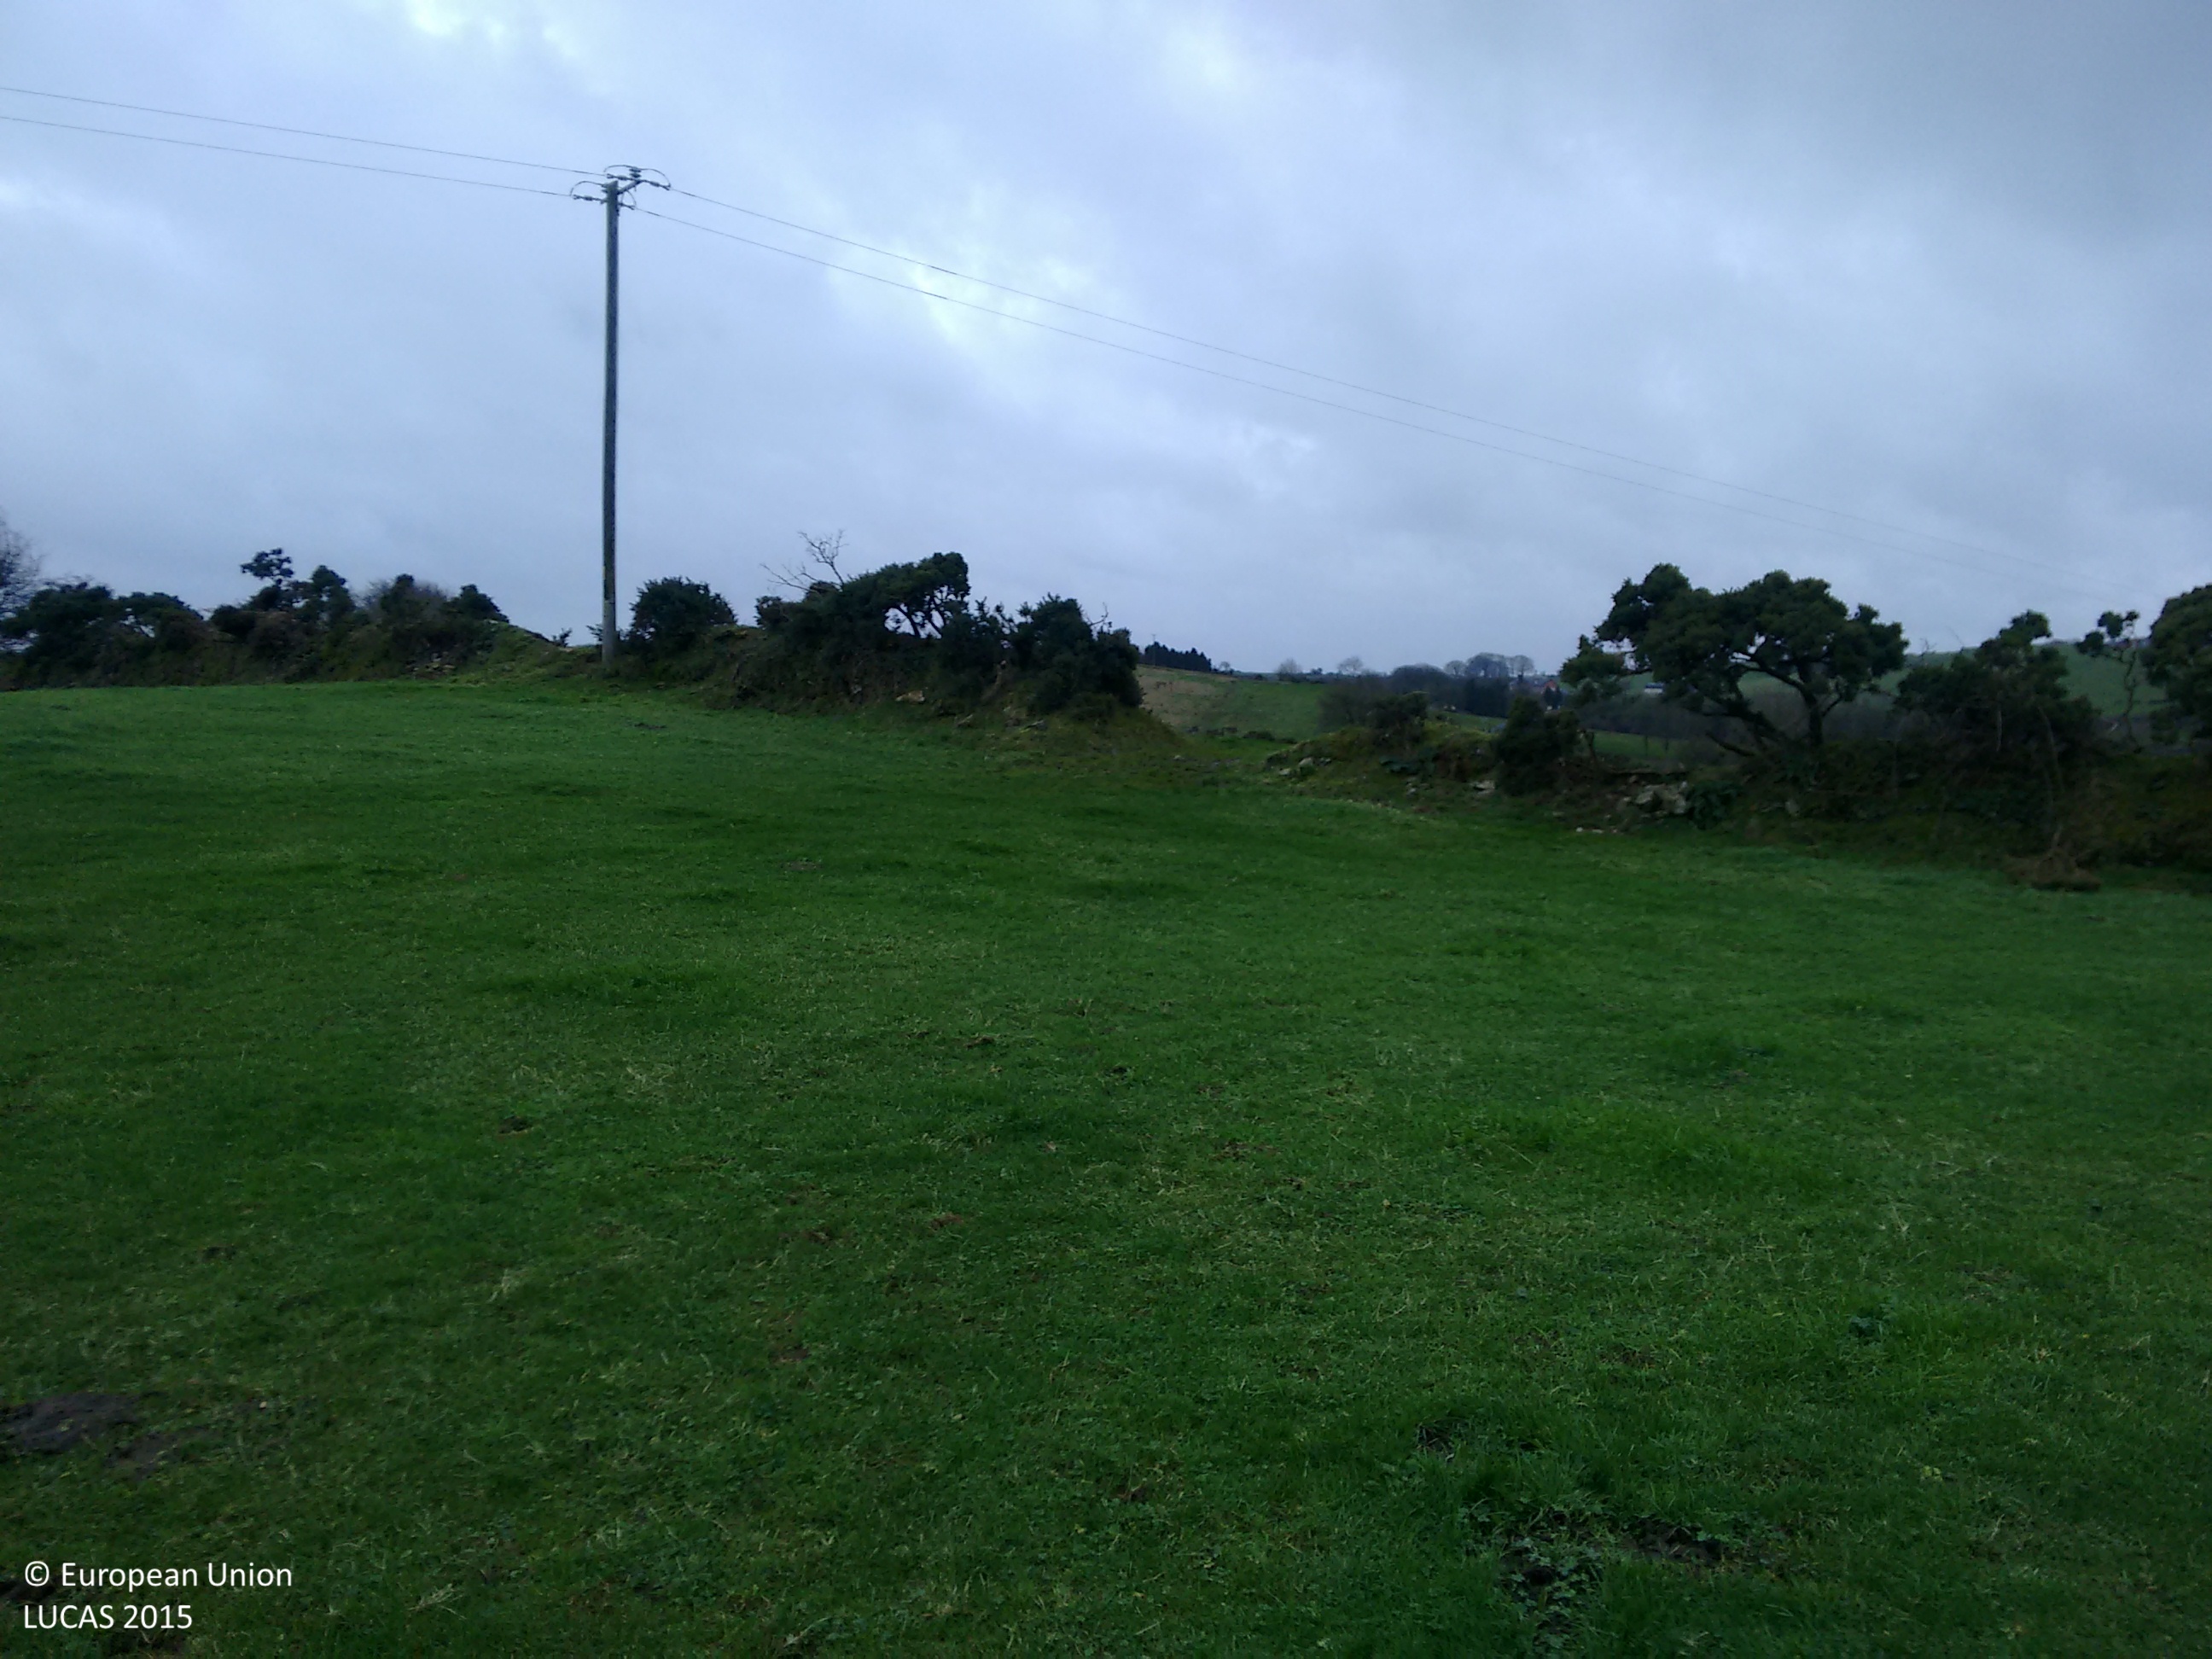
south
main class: Grassland
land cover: Grassland without tree/shrub cover
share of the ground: > 75 %
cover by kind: herbaceous plants 100 %
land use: Agriculture (excluding fallow land and kitchen gardens)
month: December
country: IE
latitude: 53.9342
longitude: -6.8767
